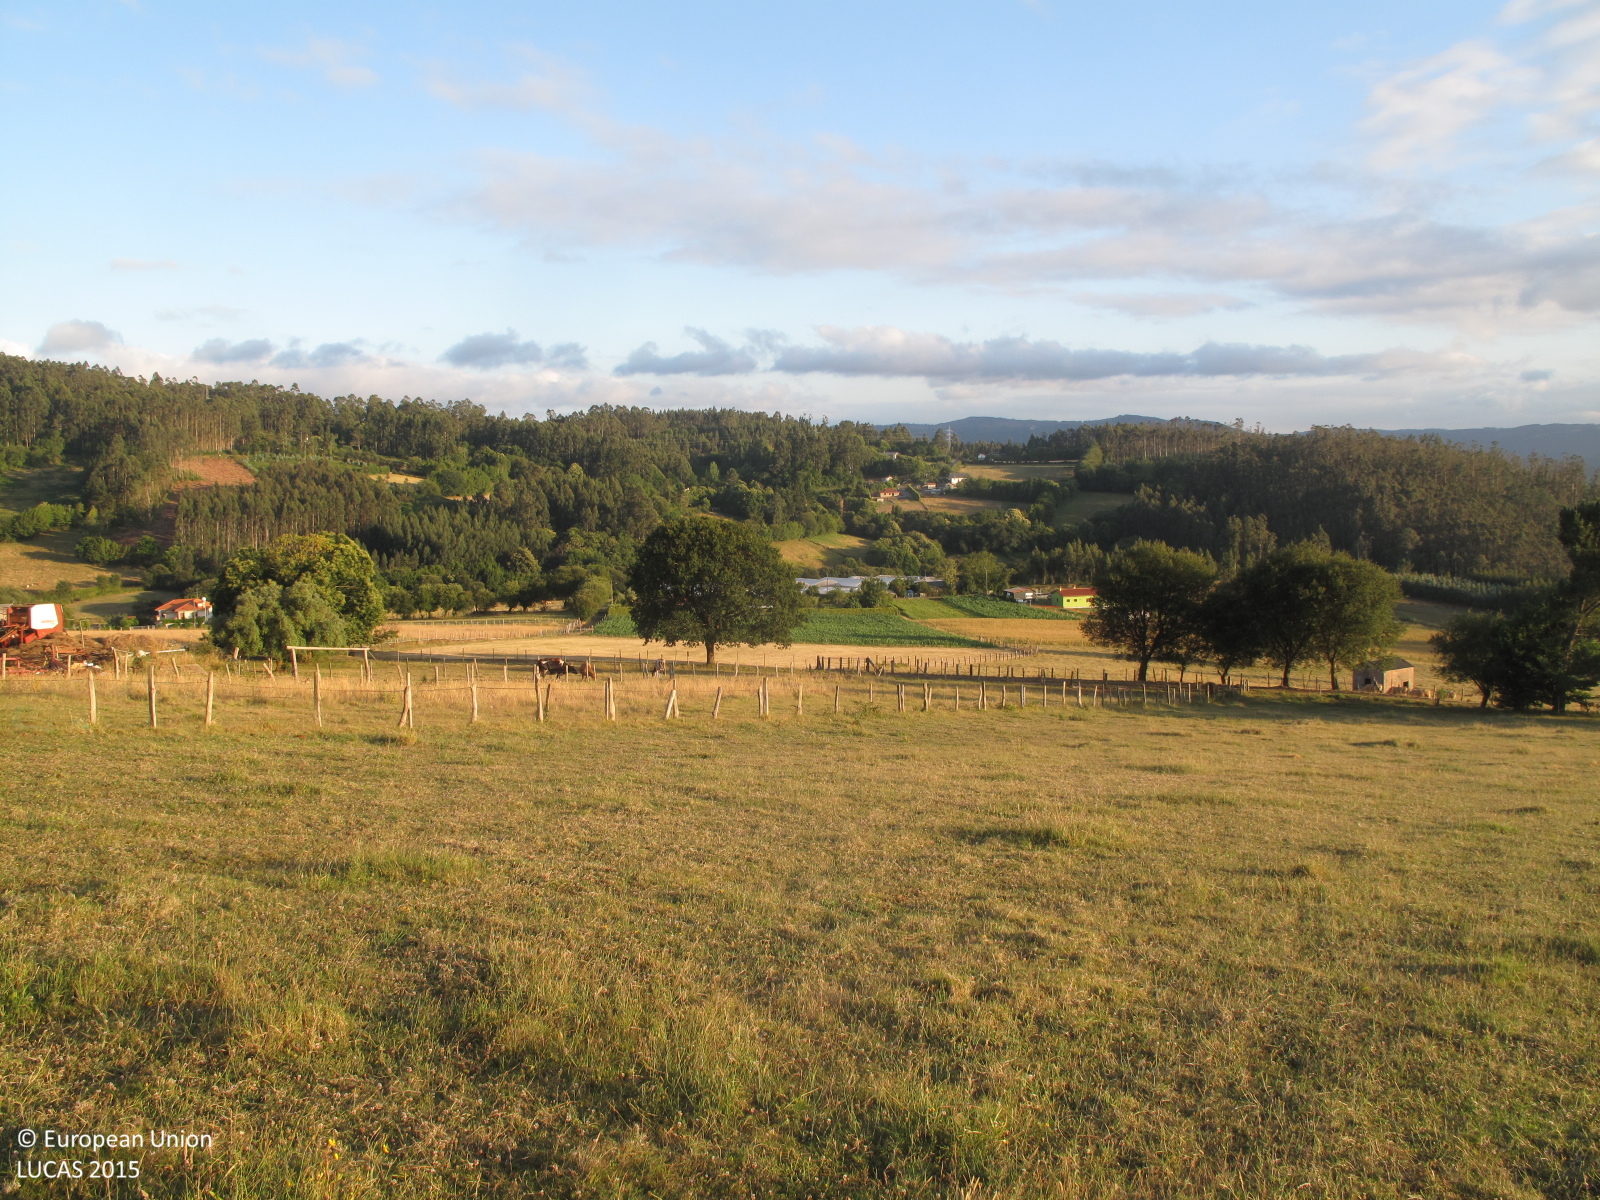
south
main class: Grassland
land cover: Grassland without tree/shrub cover
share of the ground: > 75 %
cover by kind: herbaceous plants 100 %
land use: Agriculture (excluding fallow land and kitchen gardens)
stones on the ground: 10 - 25 %
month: July
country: ES
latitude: 43.5611
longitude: -8.0620
